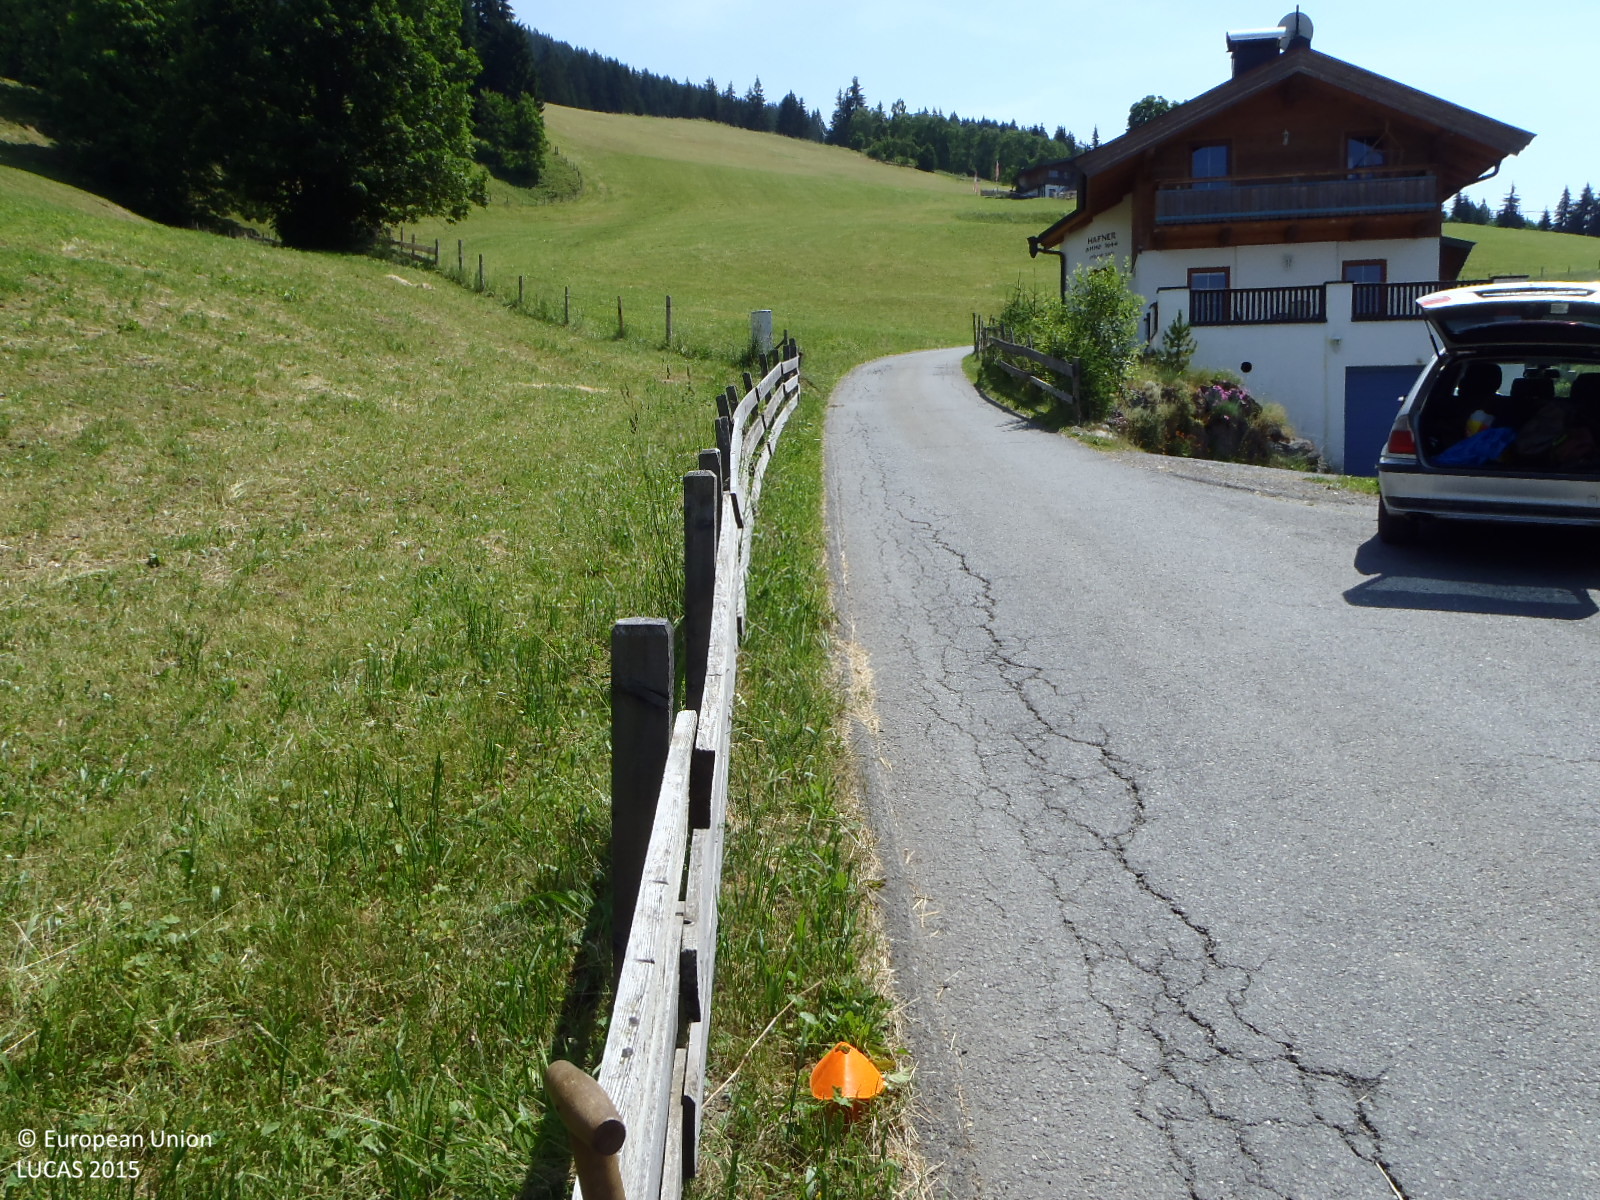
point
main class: Grassland
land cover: Grassland without tree/shrub cover
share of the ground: > 75 %
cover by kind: herbaceous plants 100 %
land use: Agriculture (excluding fallow land and kitchen gardens)
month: July
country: AT
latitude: 47.4070
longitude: 12.3174
